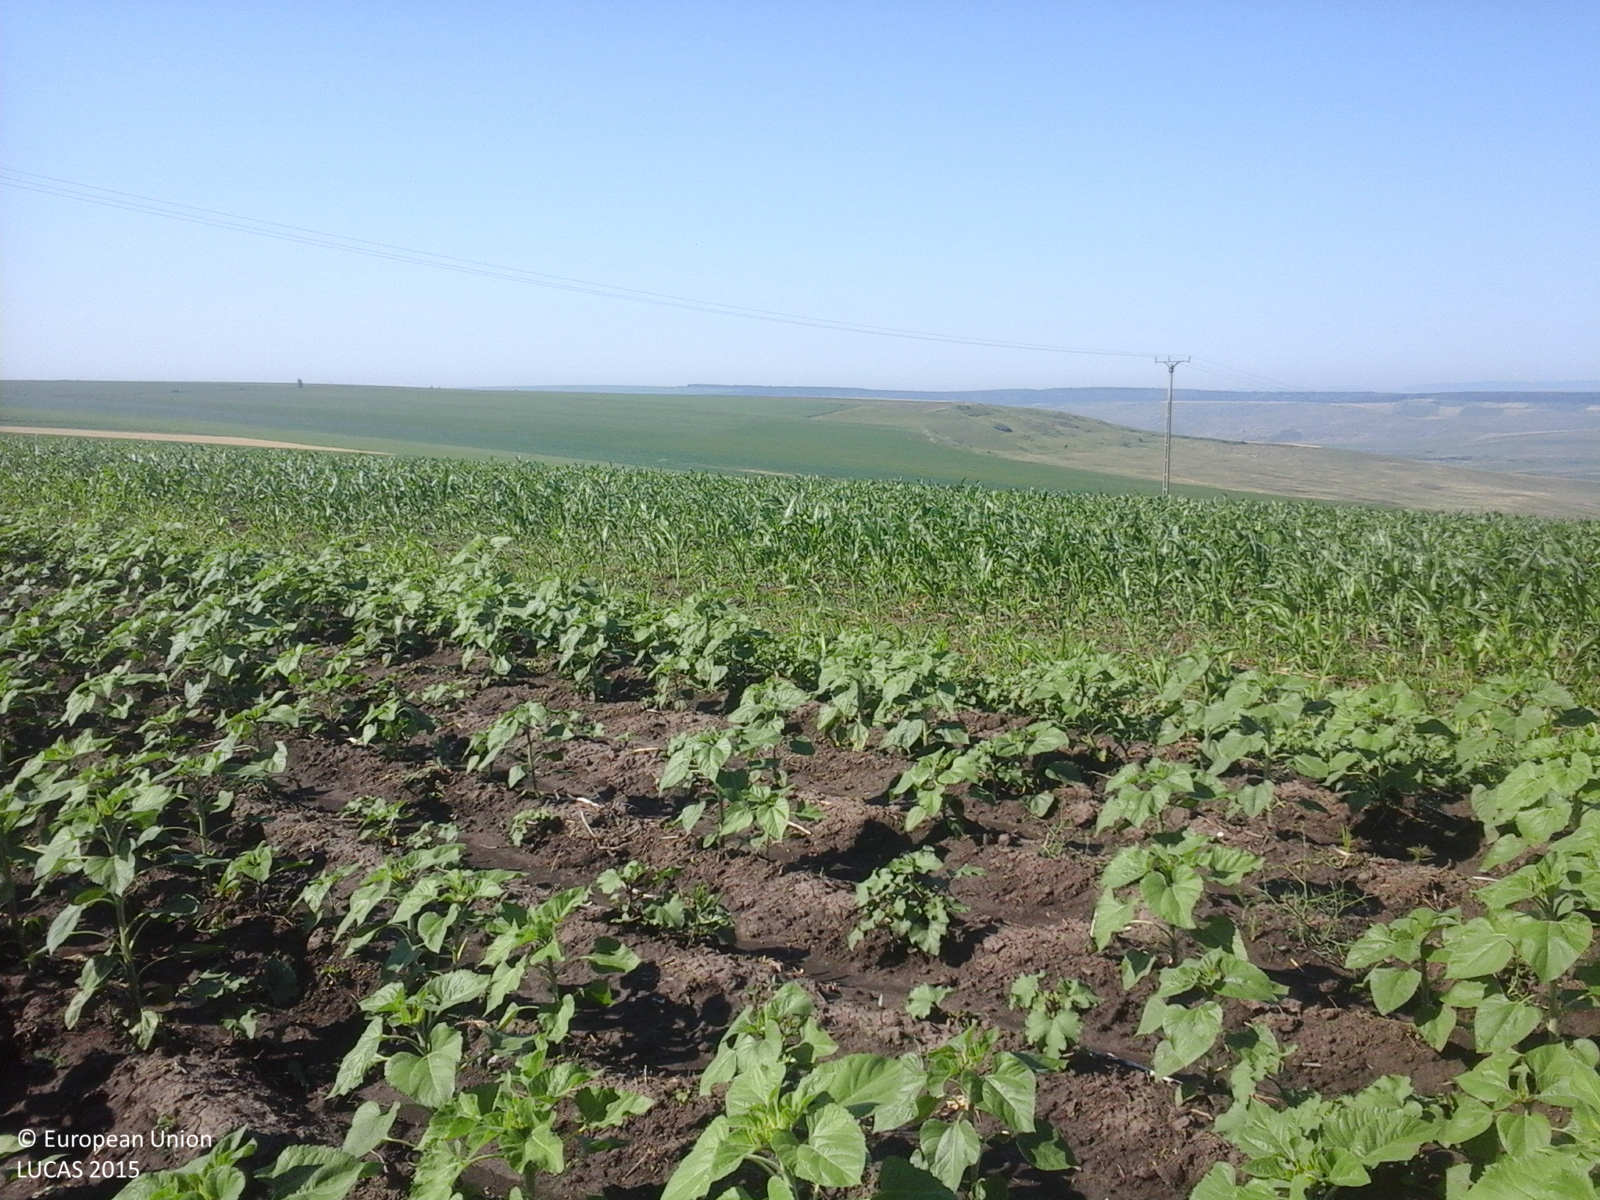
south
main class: Cropland
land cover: Sunflower
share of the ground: 50 - 75 %
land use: Agriculture (excluding fallow land and kitchen gardens)
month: June
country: RO
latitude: 47.7020
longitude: 27.0984
